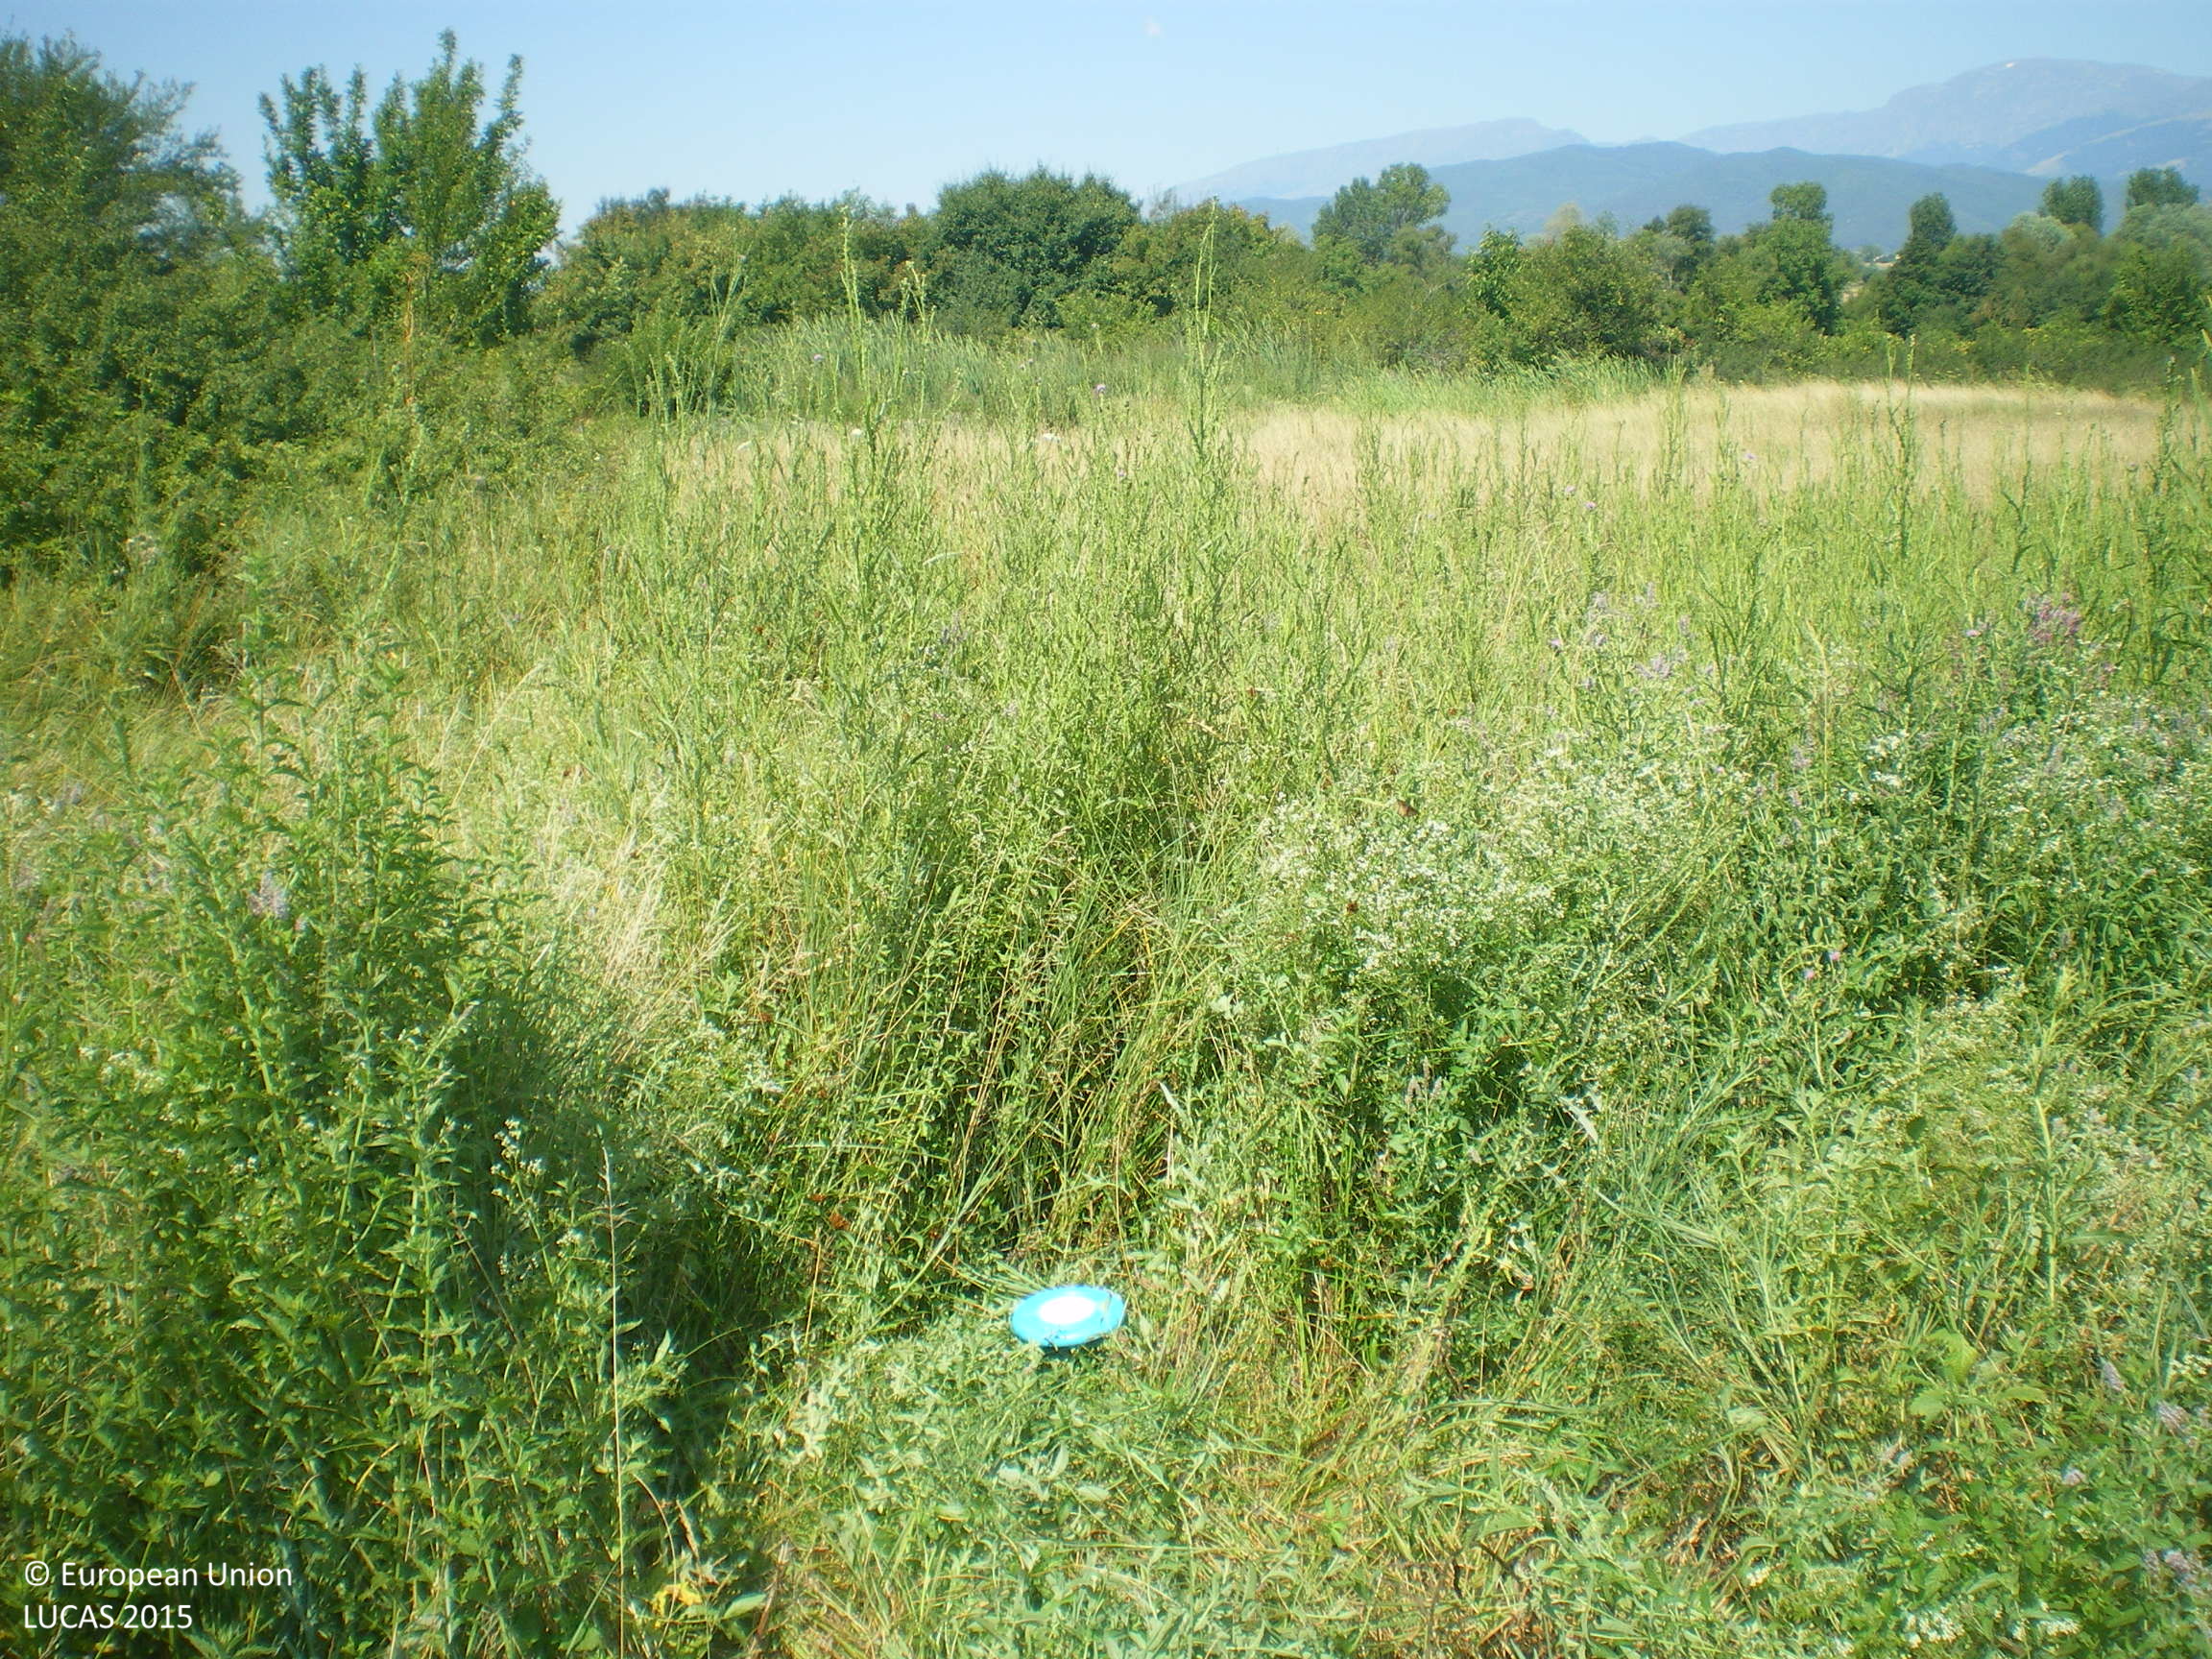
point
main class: Grassland
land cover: Spontaneously vegetated surfaces
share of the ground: > 75 %
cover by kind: herbaceous plants 100 %
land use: Semi-natural and natural areas not in use
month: July
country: BG
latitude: 42.5943
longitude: 25.1143
